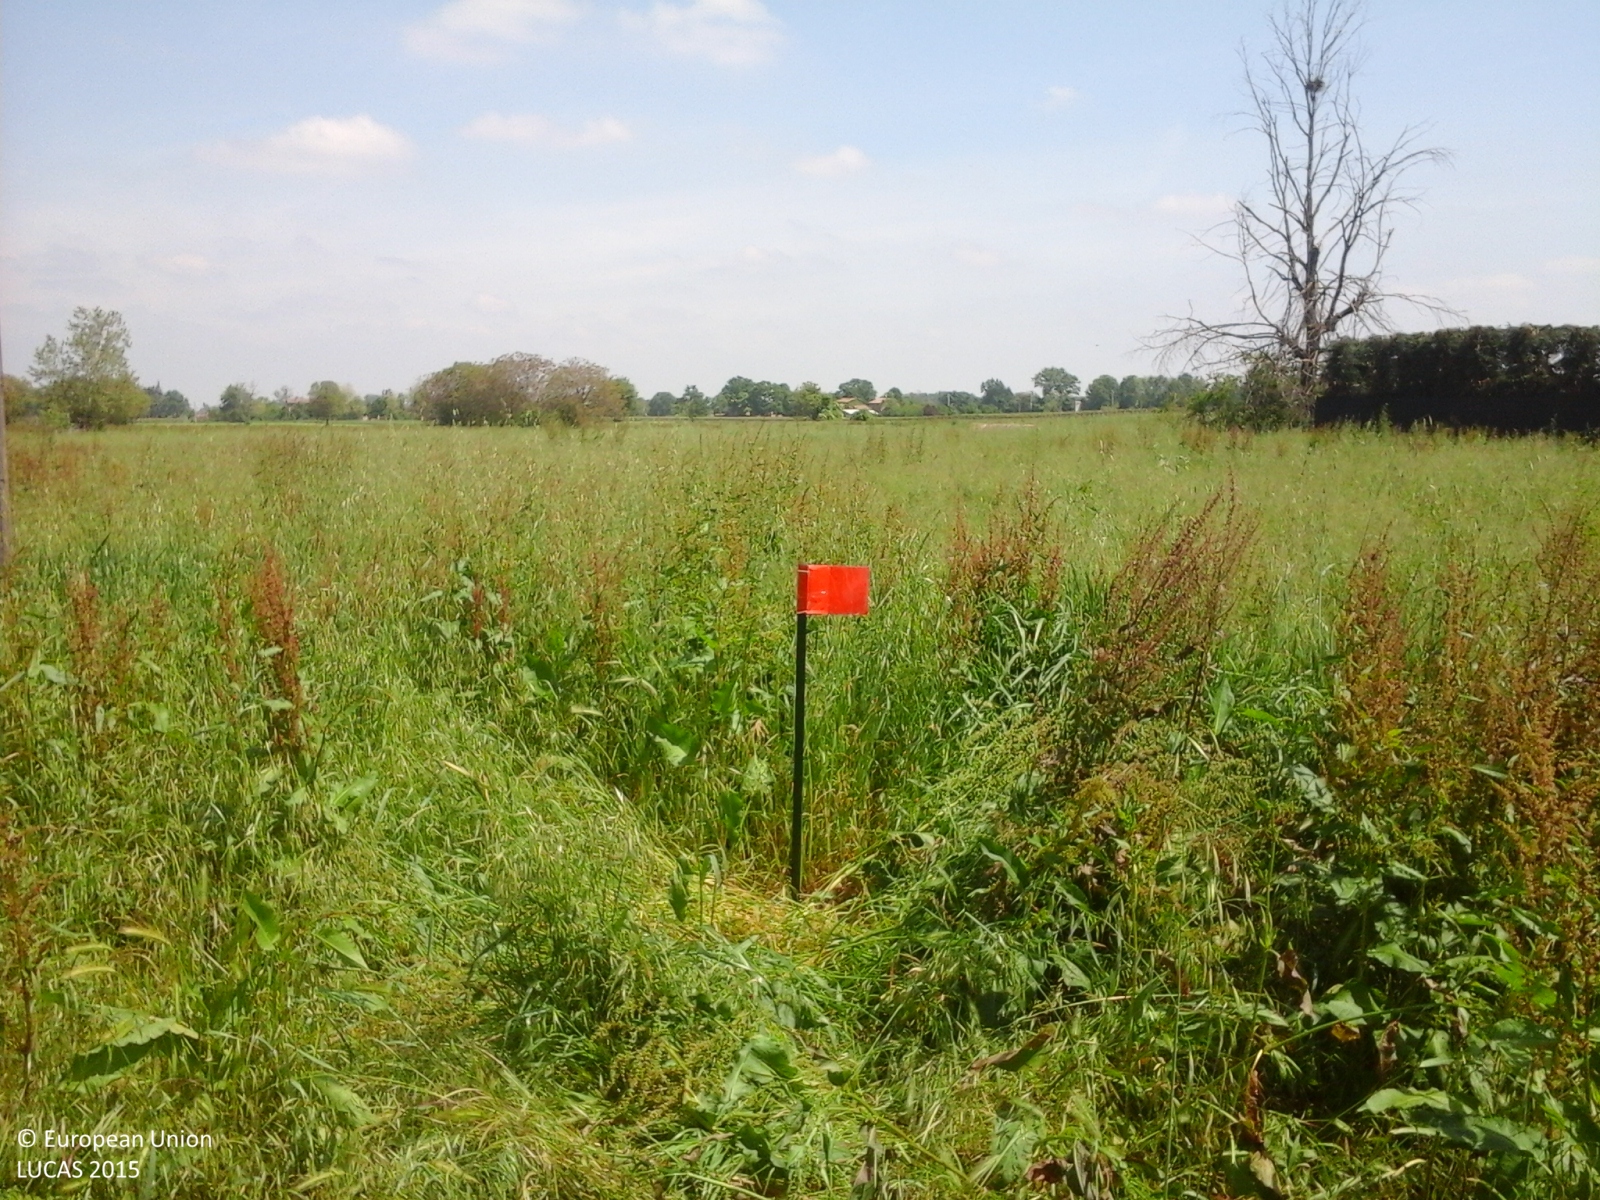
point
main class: Grassland
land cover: Spontaneously vegetated surfaces
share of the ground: > 75 %
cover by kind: herbaceous plants 100 %
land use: Agriculture (excluding fallow land and kitchen gardens)
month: May
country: IT
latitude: 44.5634
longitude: 10.8669
